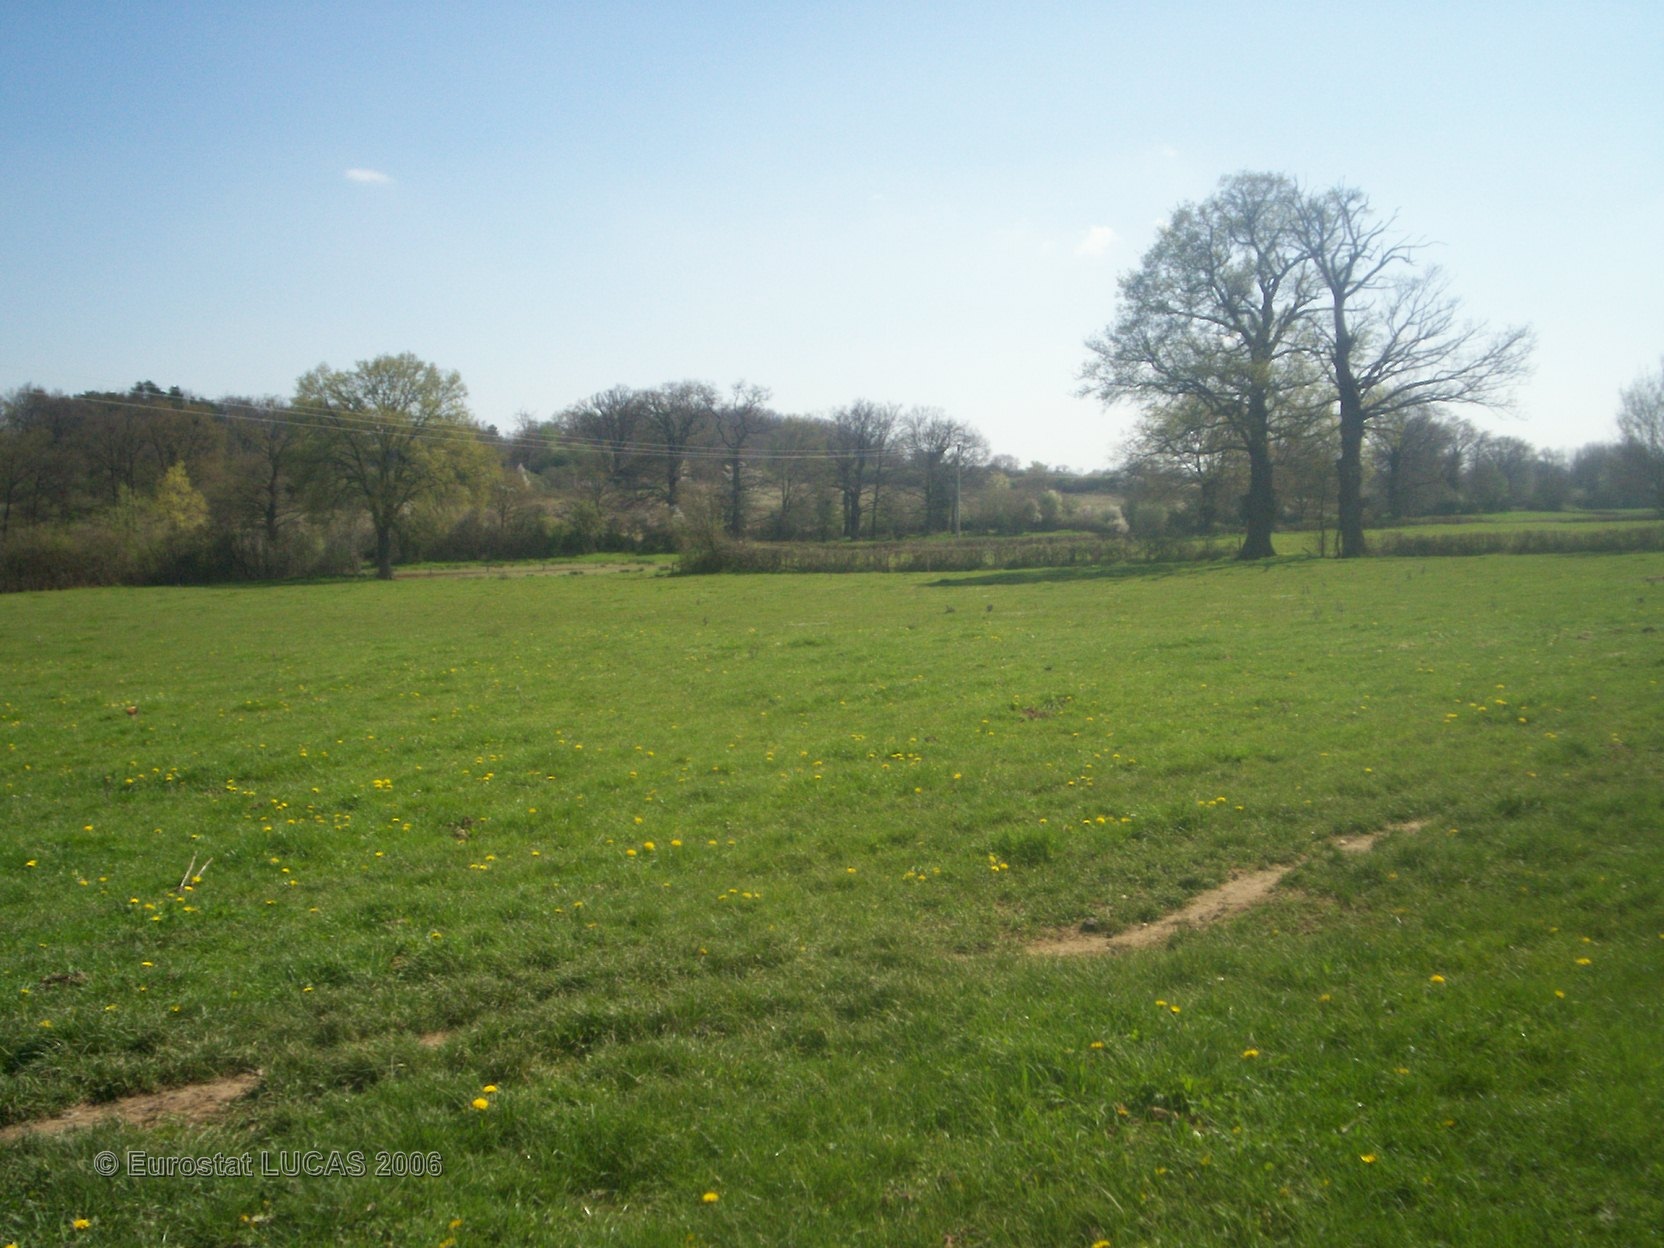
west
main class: Grassland
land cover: Grassland without tree/shrub cover
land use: Agriculture (excluding fallow land and kitchen gardens)
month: April
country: FR
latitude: 46.6189
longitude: 3.1415
